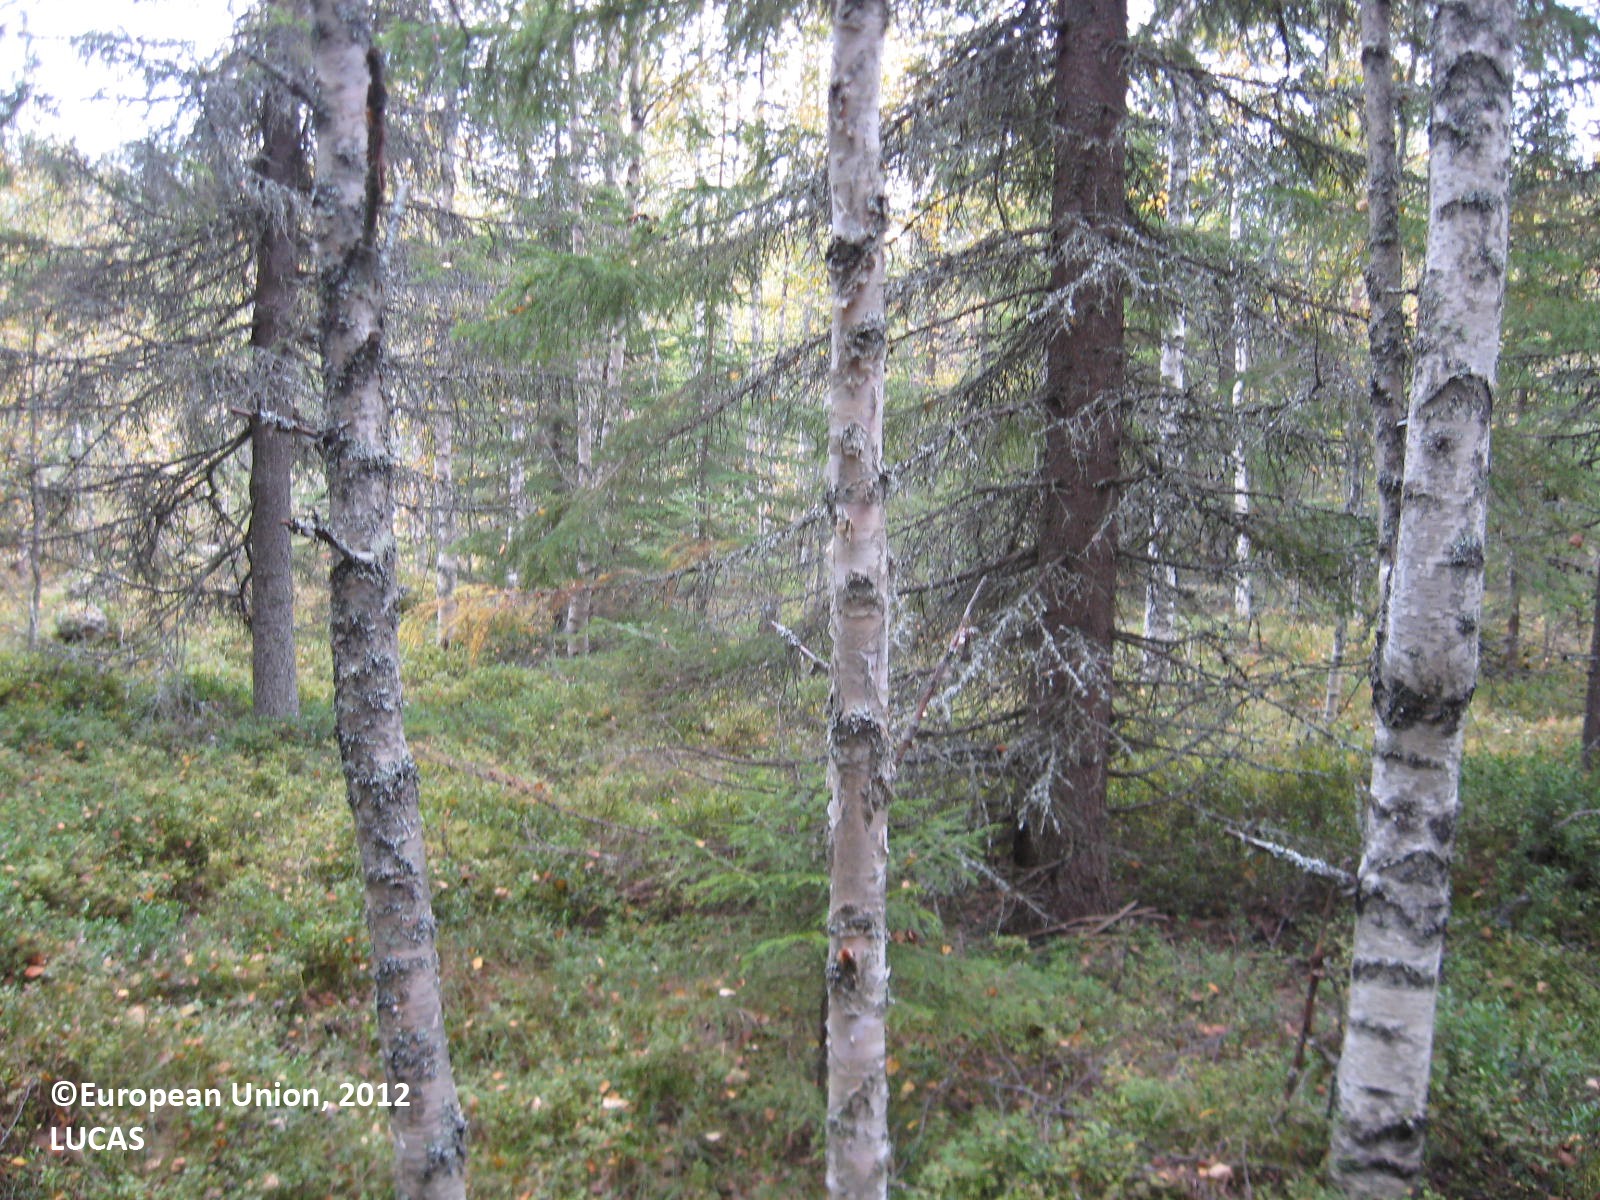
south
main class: Woodland
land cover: Other mixed woodland
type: boreal forest
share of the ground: > 75 %
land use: Forestry
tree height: > 5 m
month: August
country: FI
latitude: 63.8894
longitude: 29.1268
